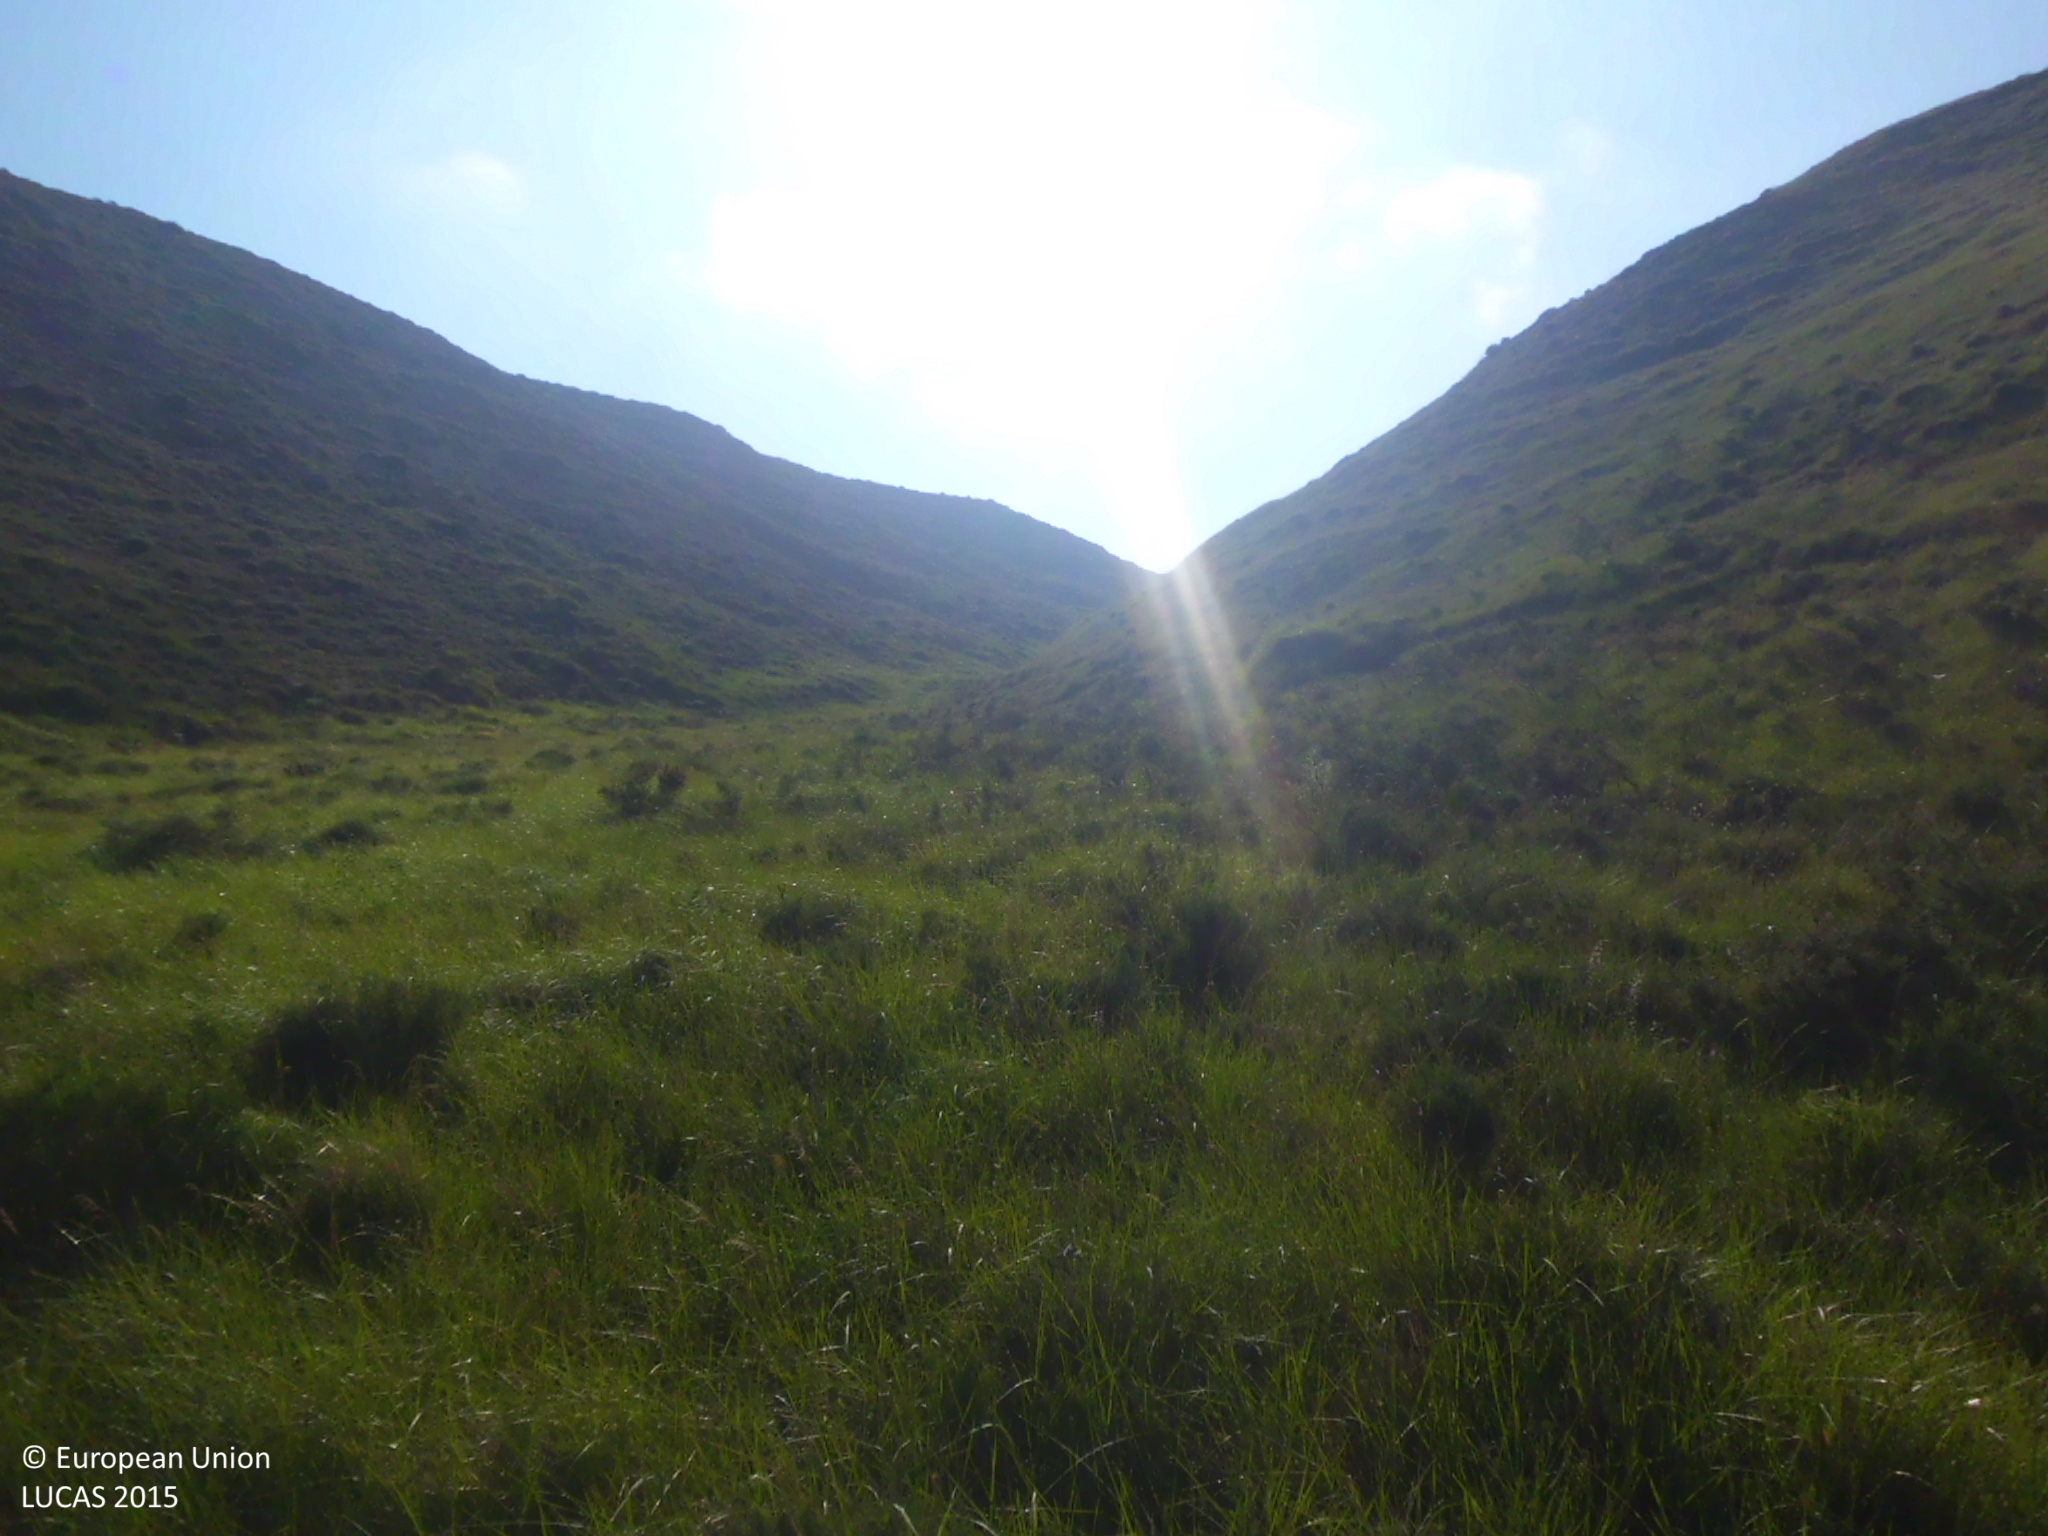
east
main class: Grassland
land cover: Grassland without tree/shrub cover
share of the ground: > 75 %
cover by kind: herbaceous plants 100 %
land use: Abandoned areas
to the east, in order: Grassland without tree/shrub cover
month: June
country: ES
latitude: 42.5266
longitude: -3.2646
